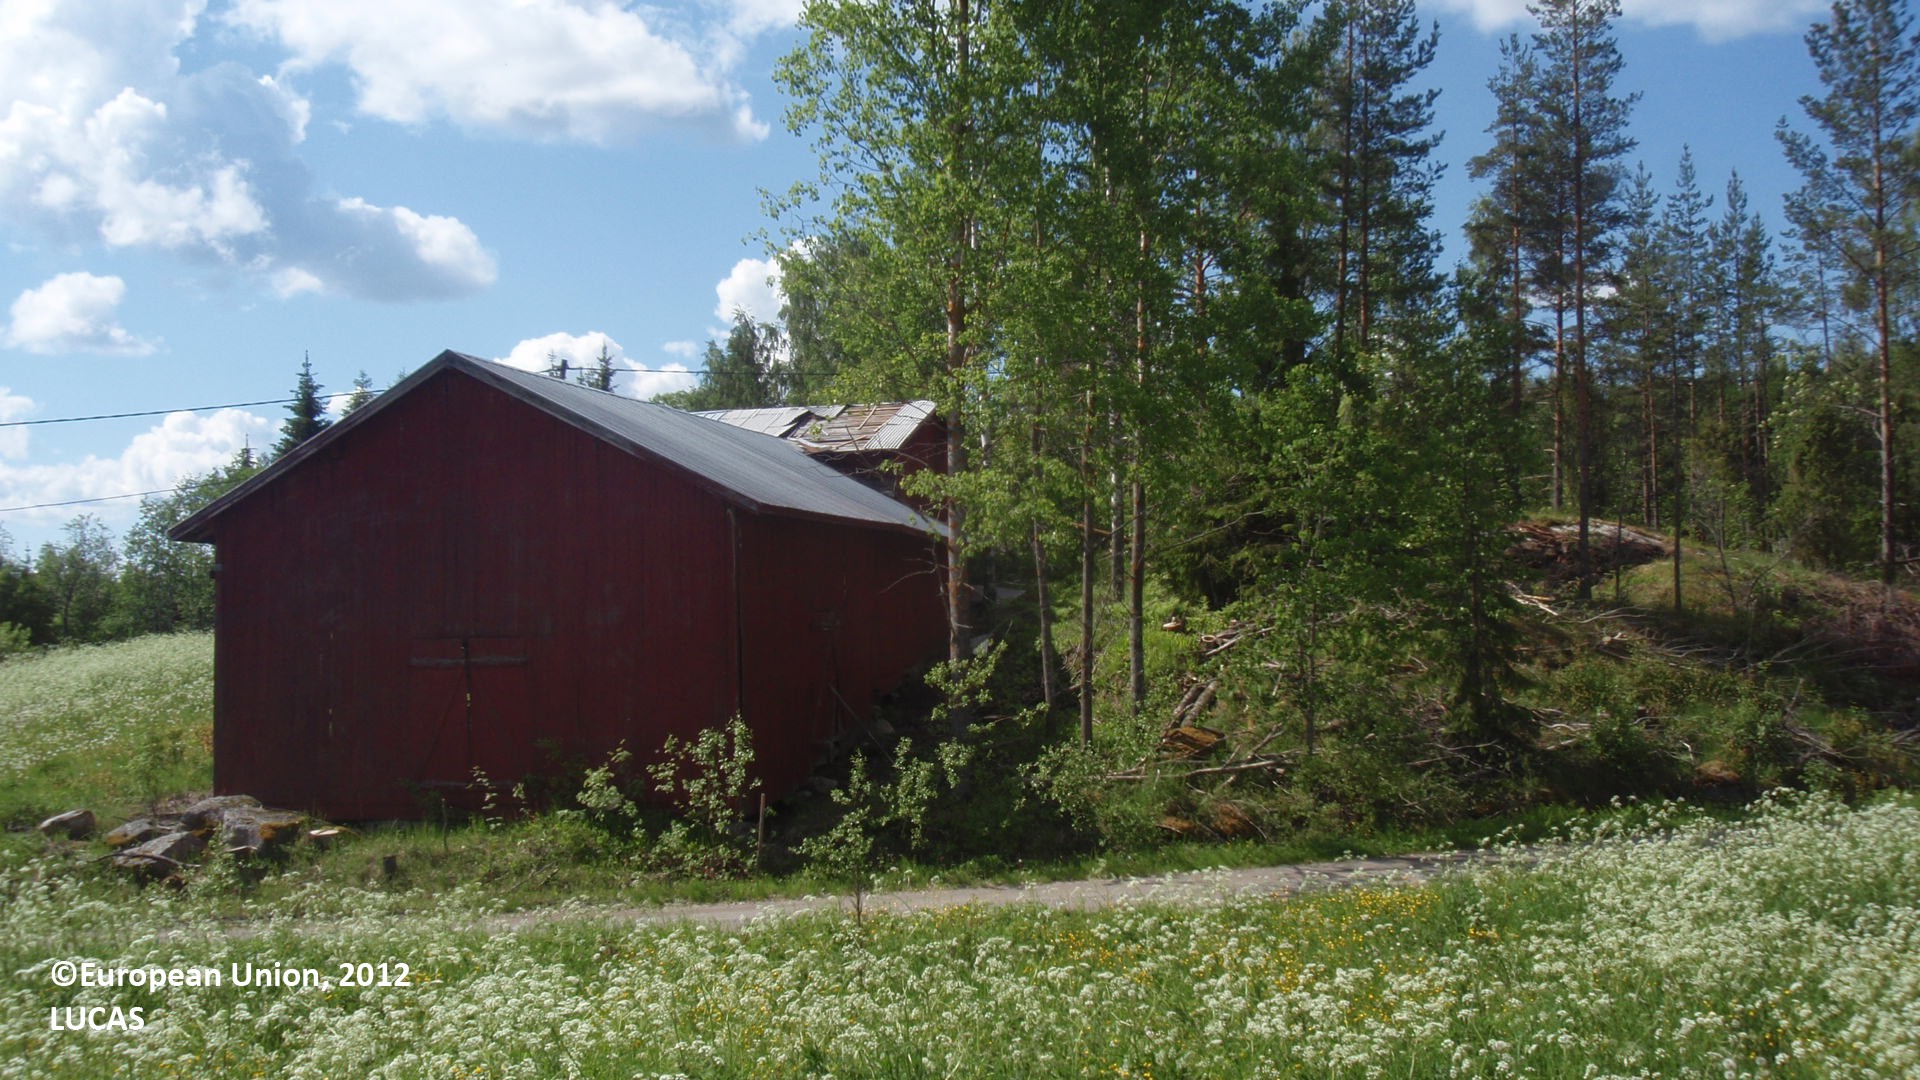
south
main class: Grassland
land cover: Spontaneously vegetated surfaces
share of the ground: > 75 %
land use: Fallow land
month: June
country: FI
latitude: 61.8178
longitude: 28.5258
